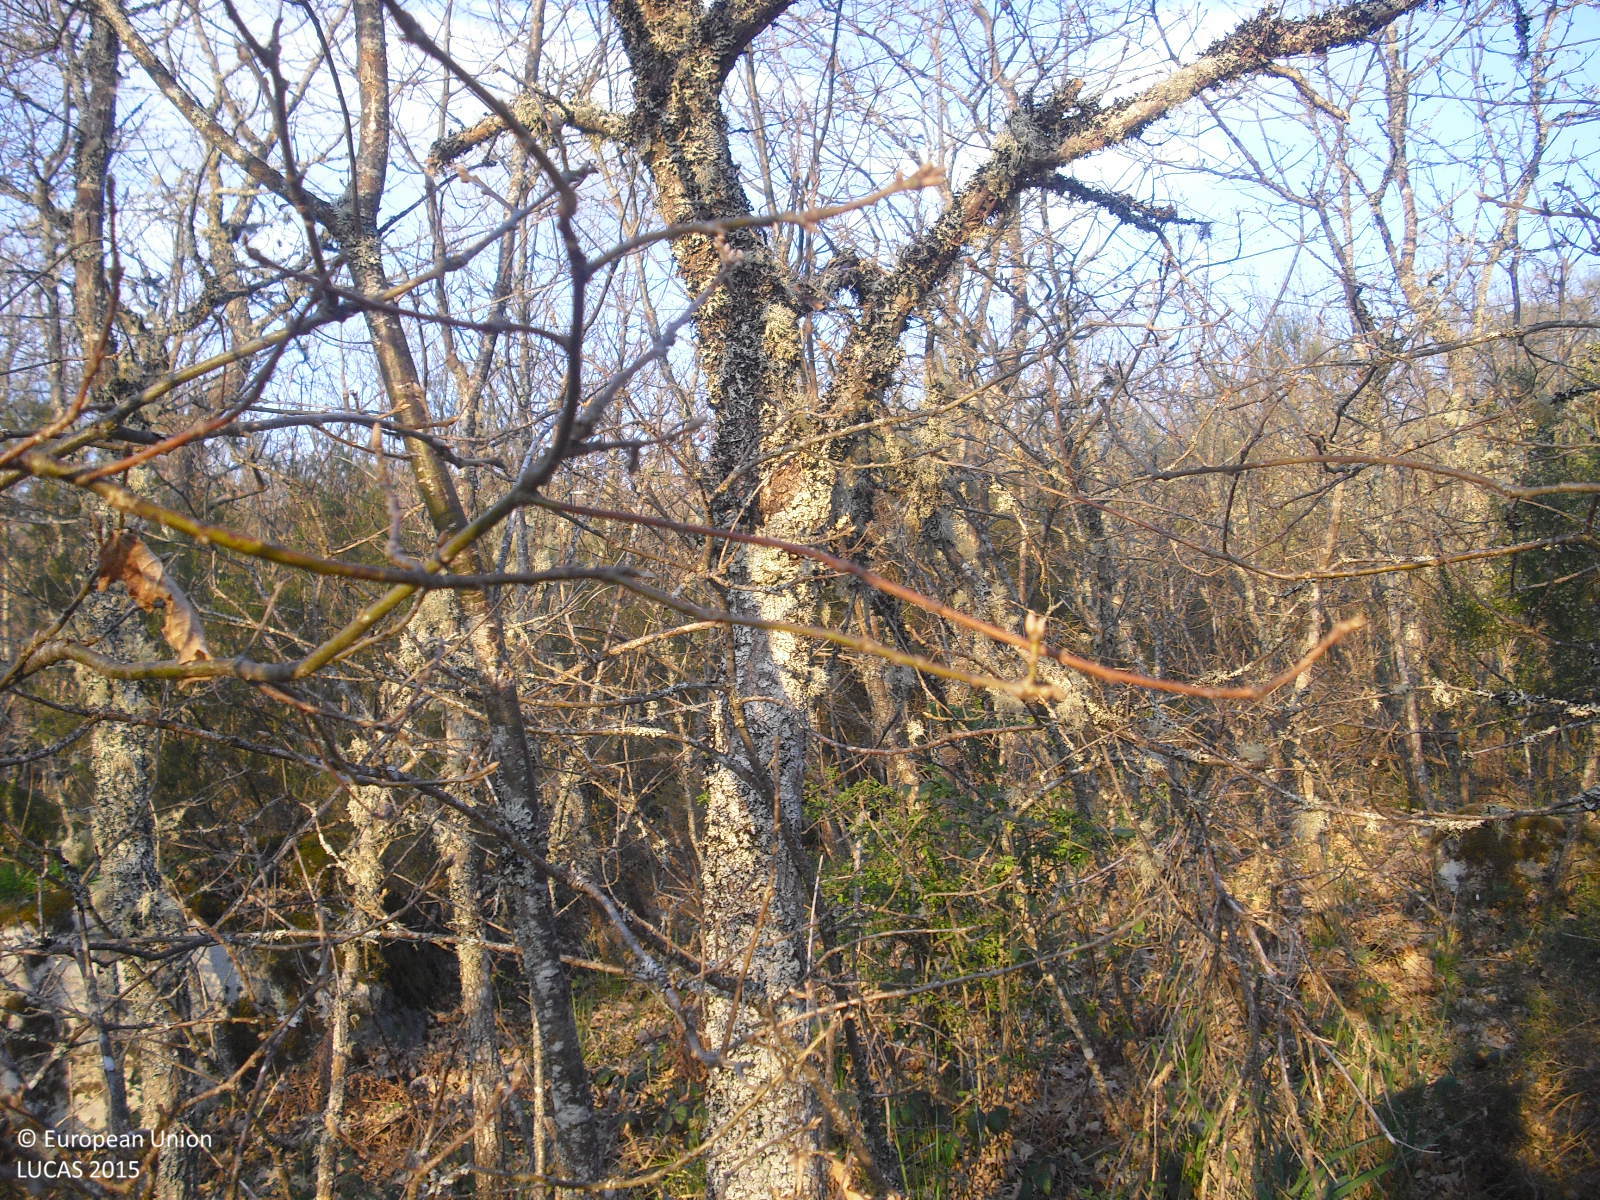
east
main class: Woodland
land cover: Broadleaved woodland
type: thermophilous deciduous forest
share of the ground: > 75 %
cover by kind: broadleaved forest trees 80 %, shrubs 10 %, herbaceous plants 5 %, consolidated bare surface 5 %
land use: Forestry
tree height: > 5 m
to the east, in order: Broadleaved woodland; Rock outcrops; Broadleaved woodland; Tracks; Broadleaved woodland; Rivers and streams; Broadleaved woodland; Rock outcrops; Broadleaved woodland; Tracks; Broadleaved woodland; Tracks; Broadleaved woodland
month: April
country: ES
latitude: 41.9628
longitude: -7.8194
